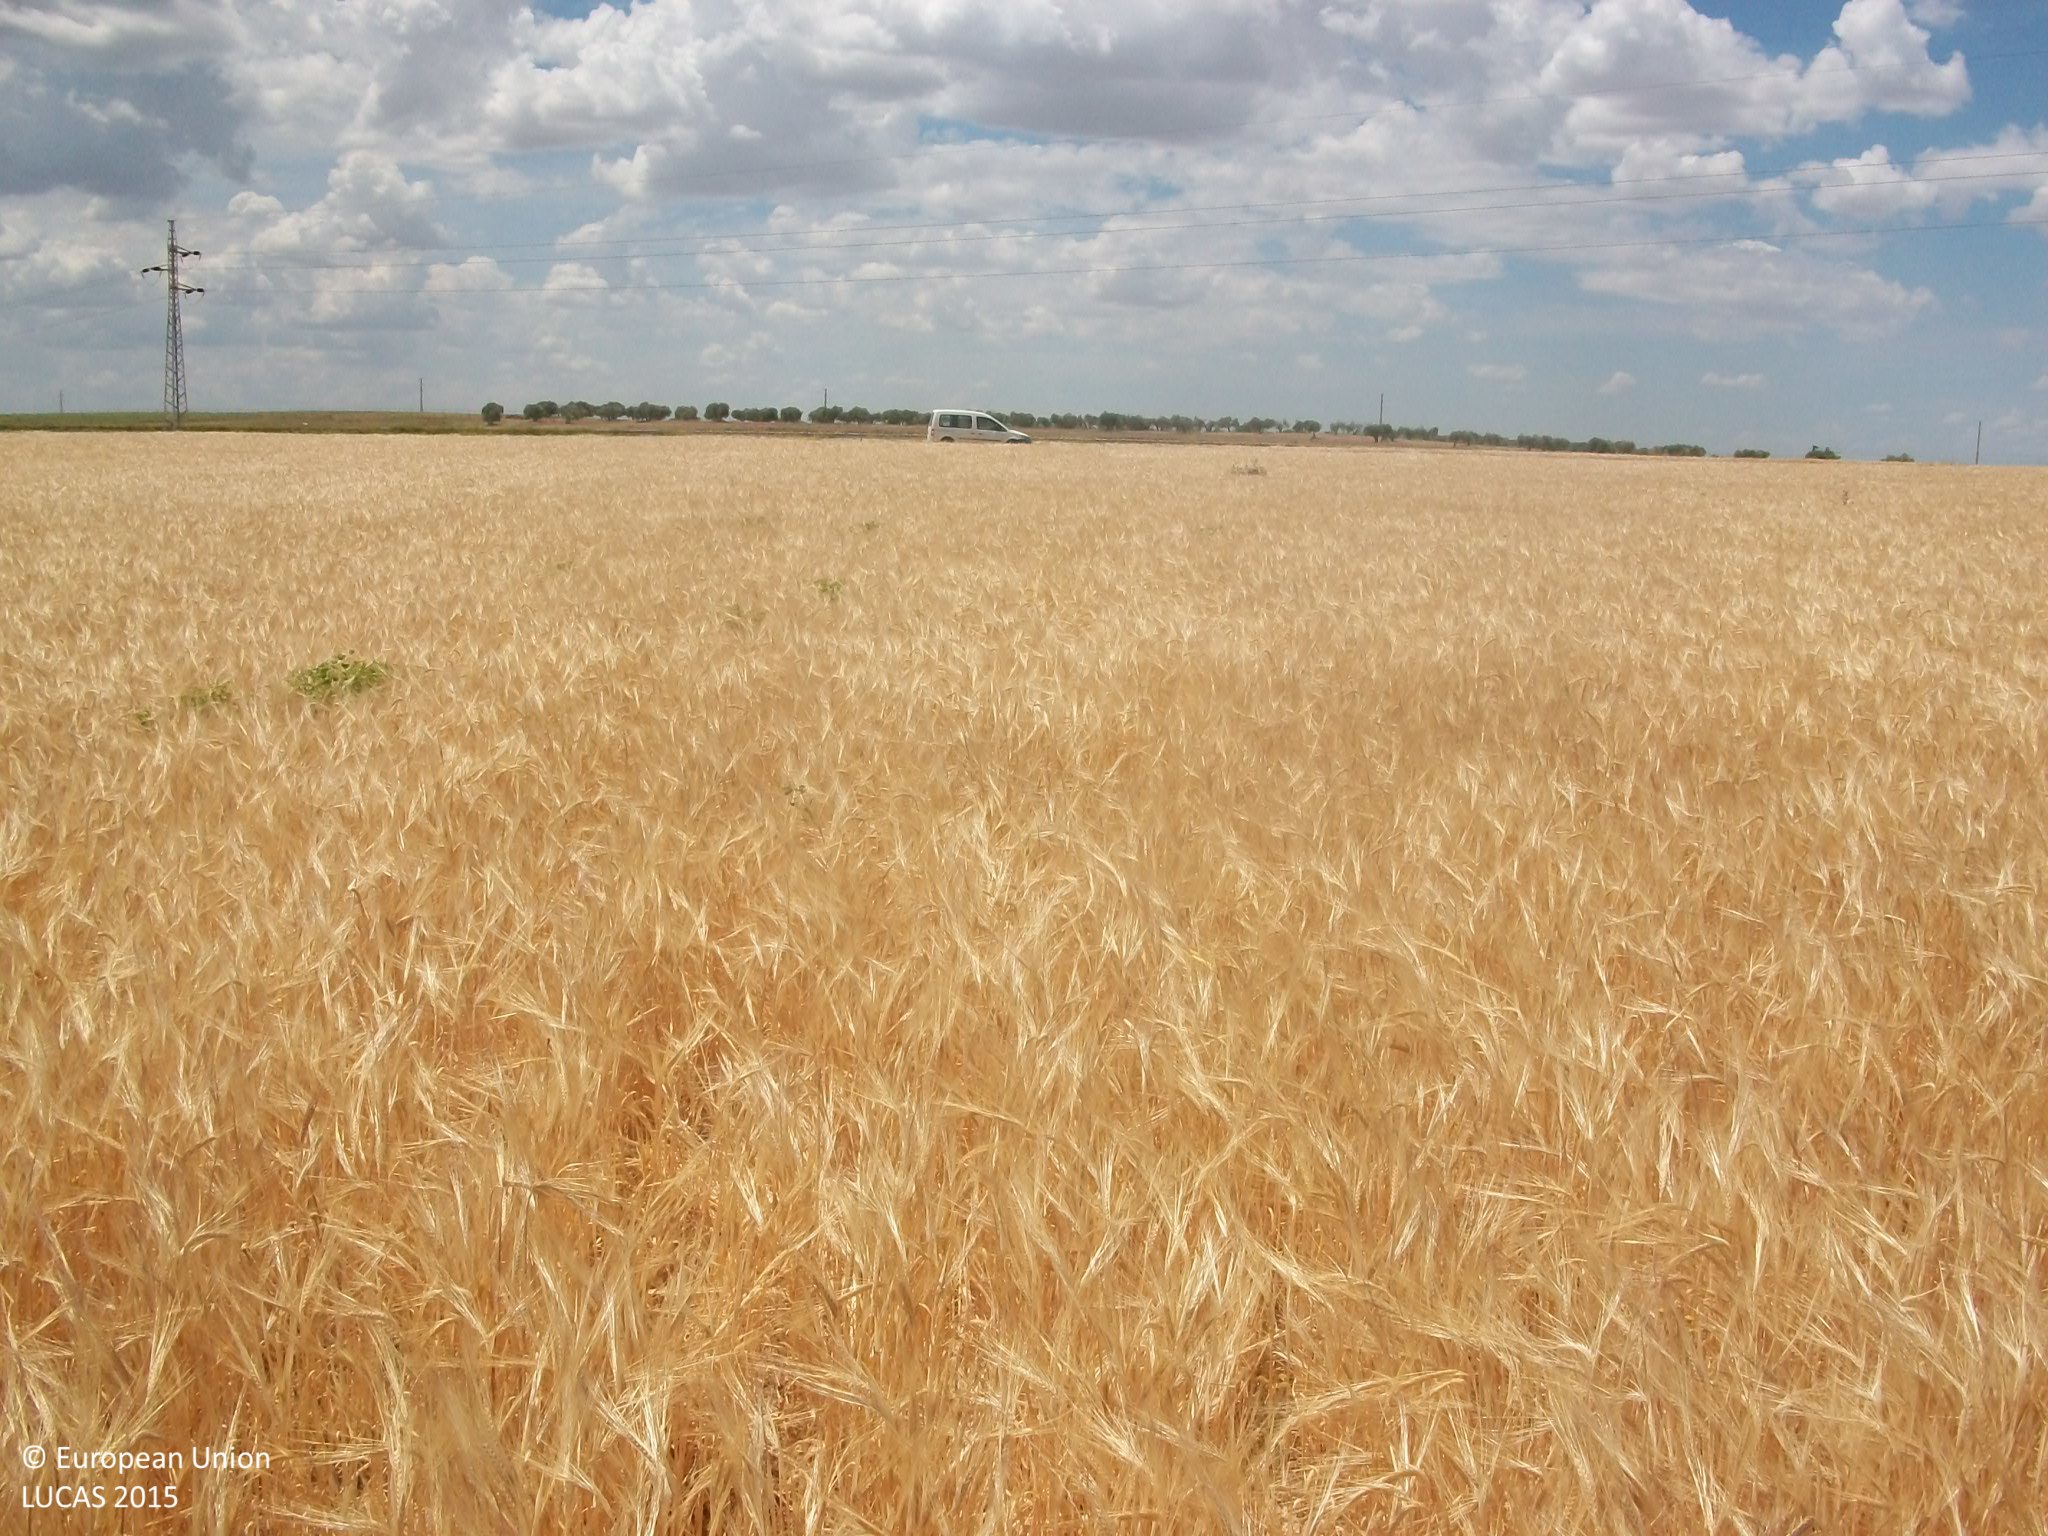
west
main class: Cropland
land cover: Barley
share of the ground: > 75 %
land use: Agriculture (excluding fallow land and kitchen gardens)
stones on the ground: 10 - 25 %
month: May
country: ES
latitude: 40.0750
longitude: -3.6701
